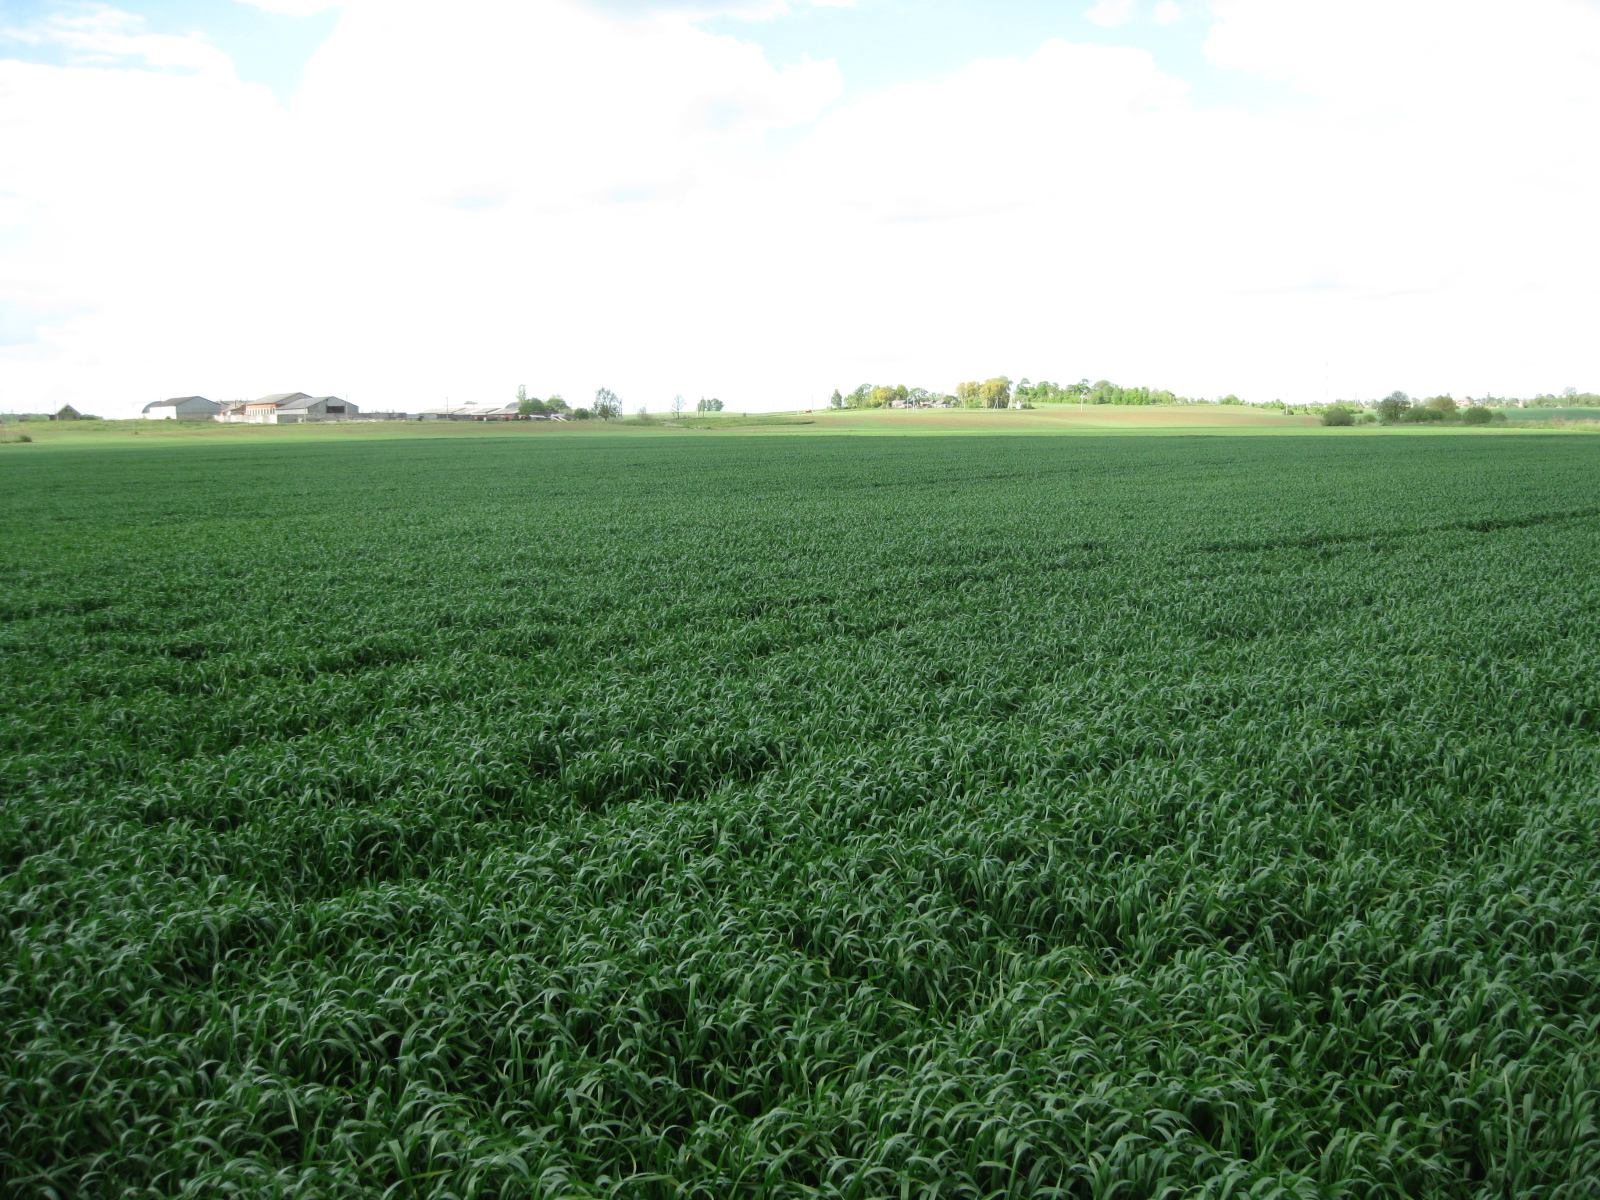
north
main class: Cropland
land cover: Common wheat
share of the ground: > 75 %
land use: Agriculture (excluding fallow land and kitchen gardens)
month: May
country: LT
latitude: 56.0609
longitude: 23.9457
